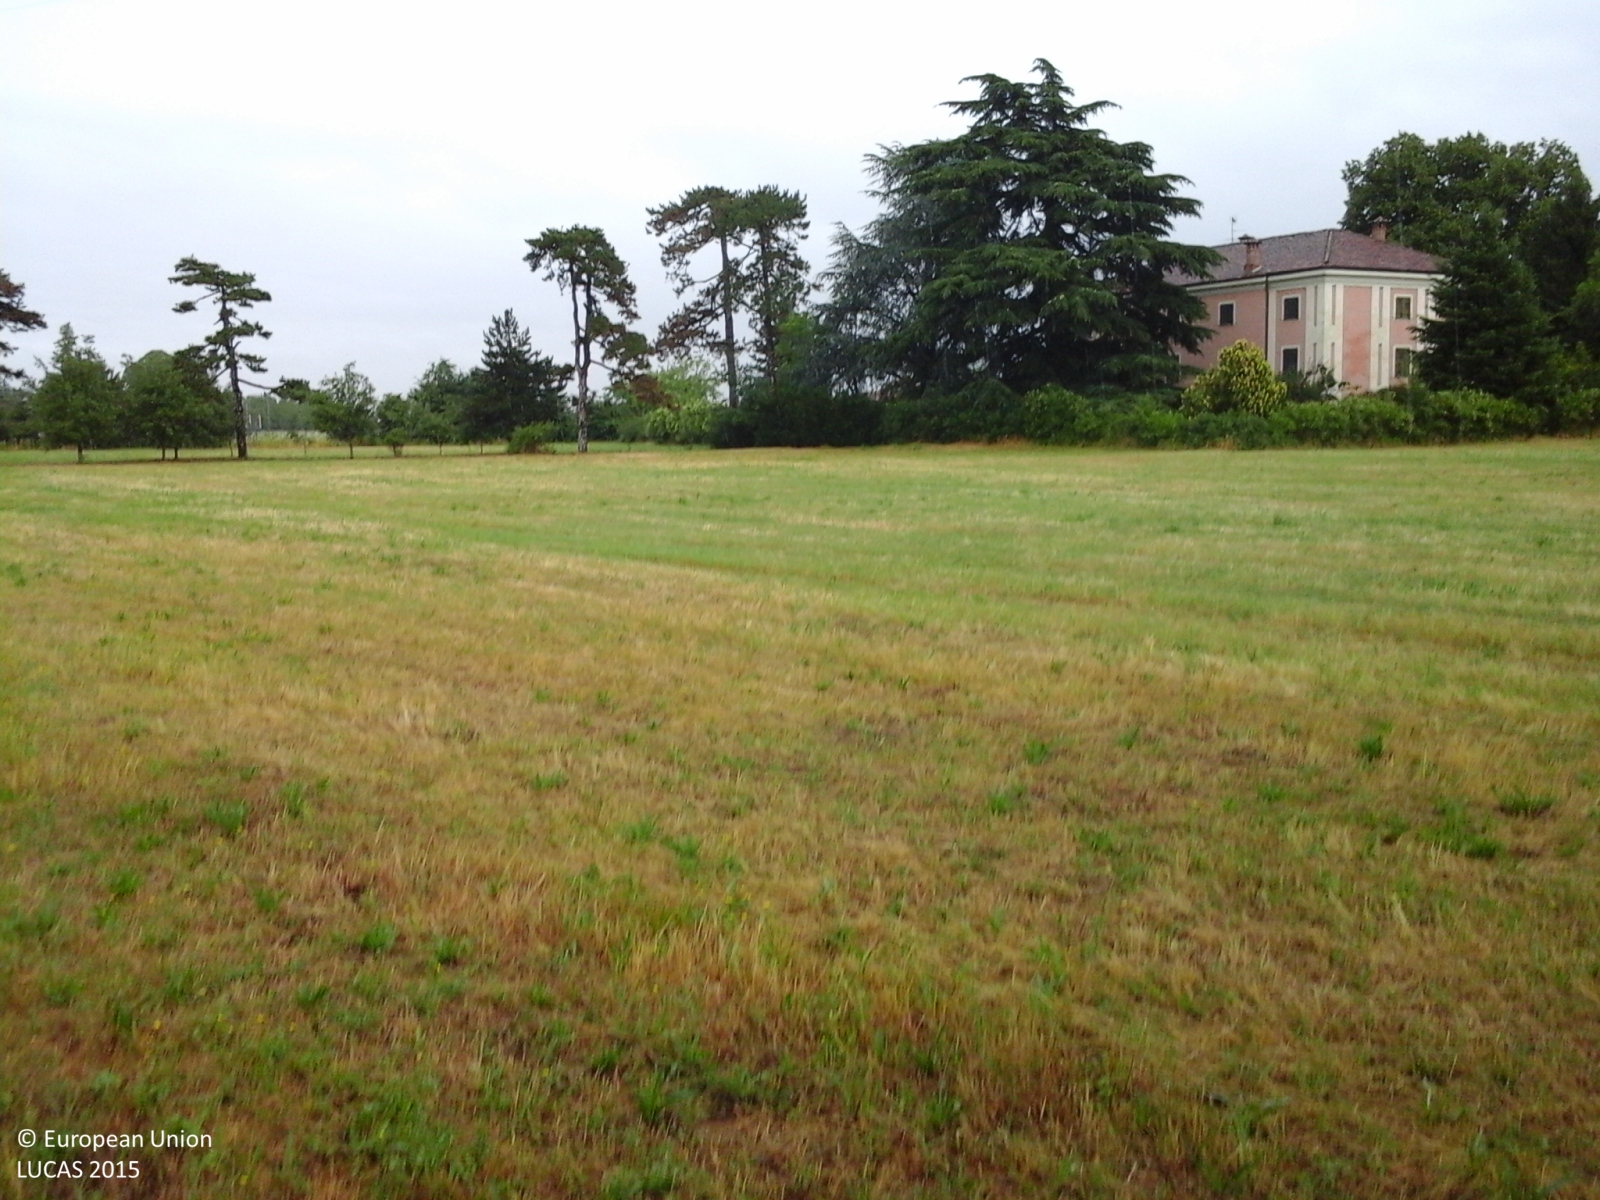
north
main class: Grassland
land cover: Spontaneously vegetated surfaces
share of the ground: > 75 %
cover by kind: herbaceous plants 100 %
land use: Agriculture (excluding fallow land and kitchen gardens)
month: June
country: IT
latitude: 44.7587
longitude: 8.8275
